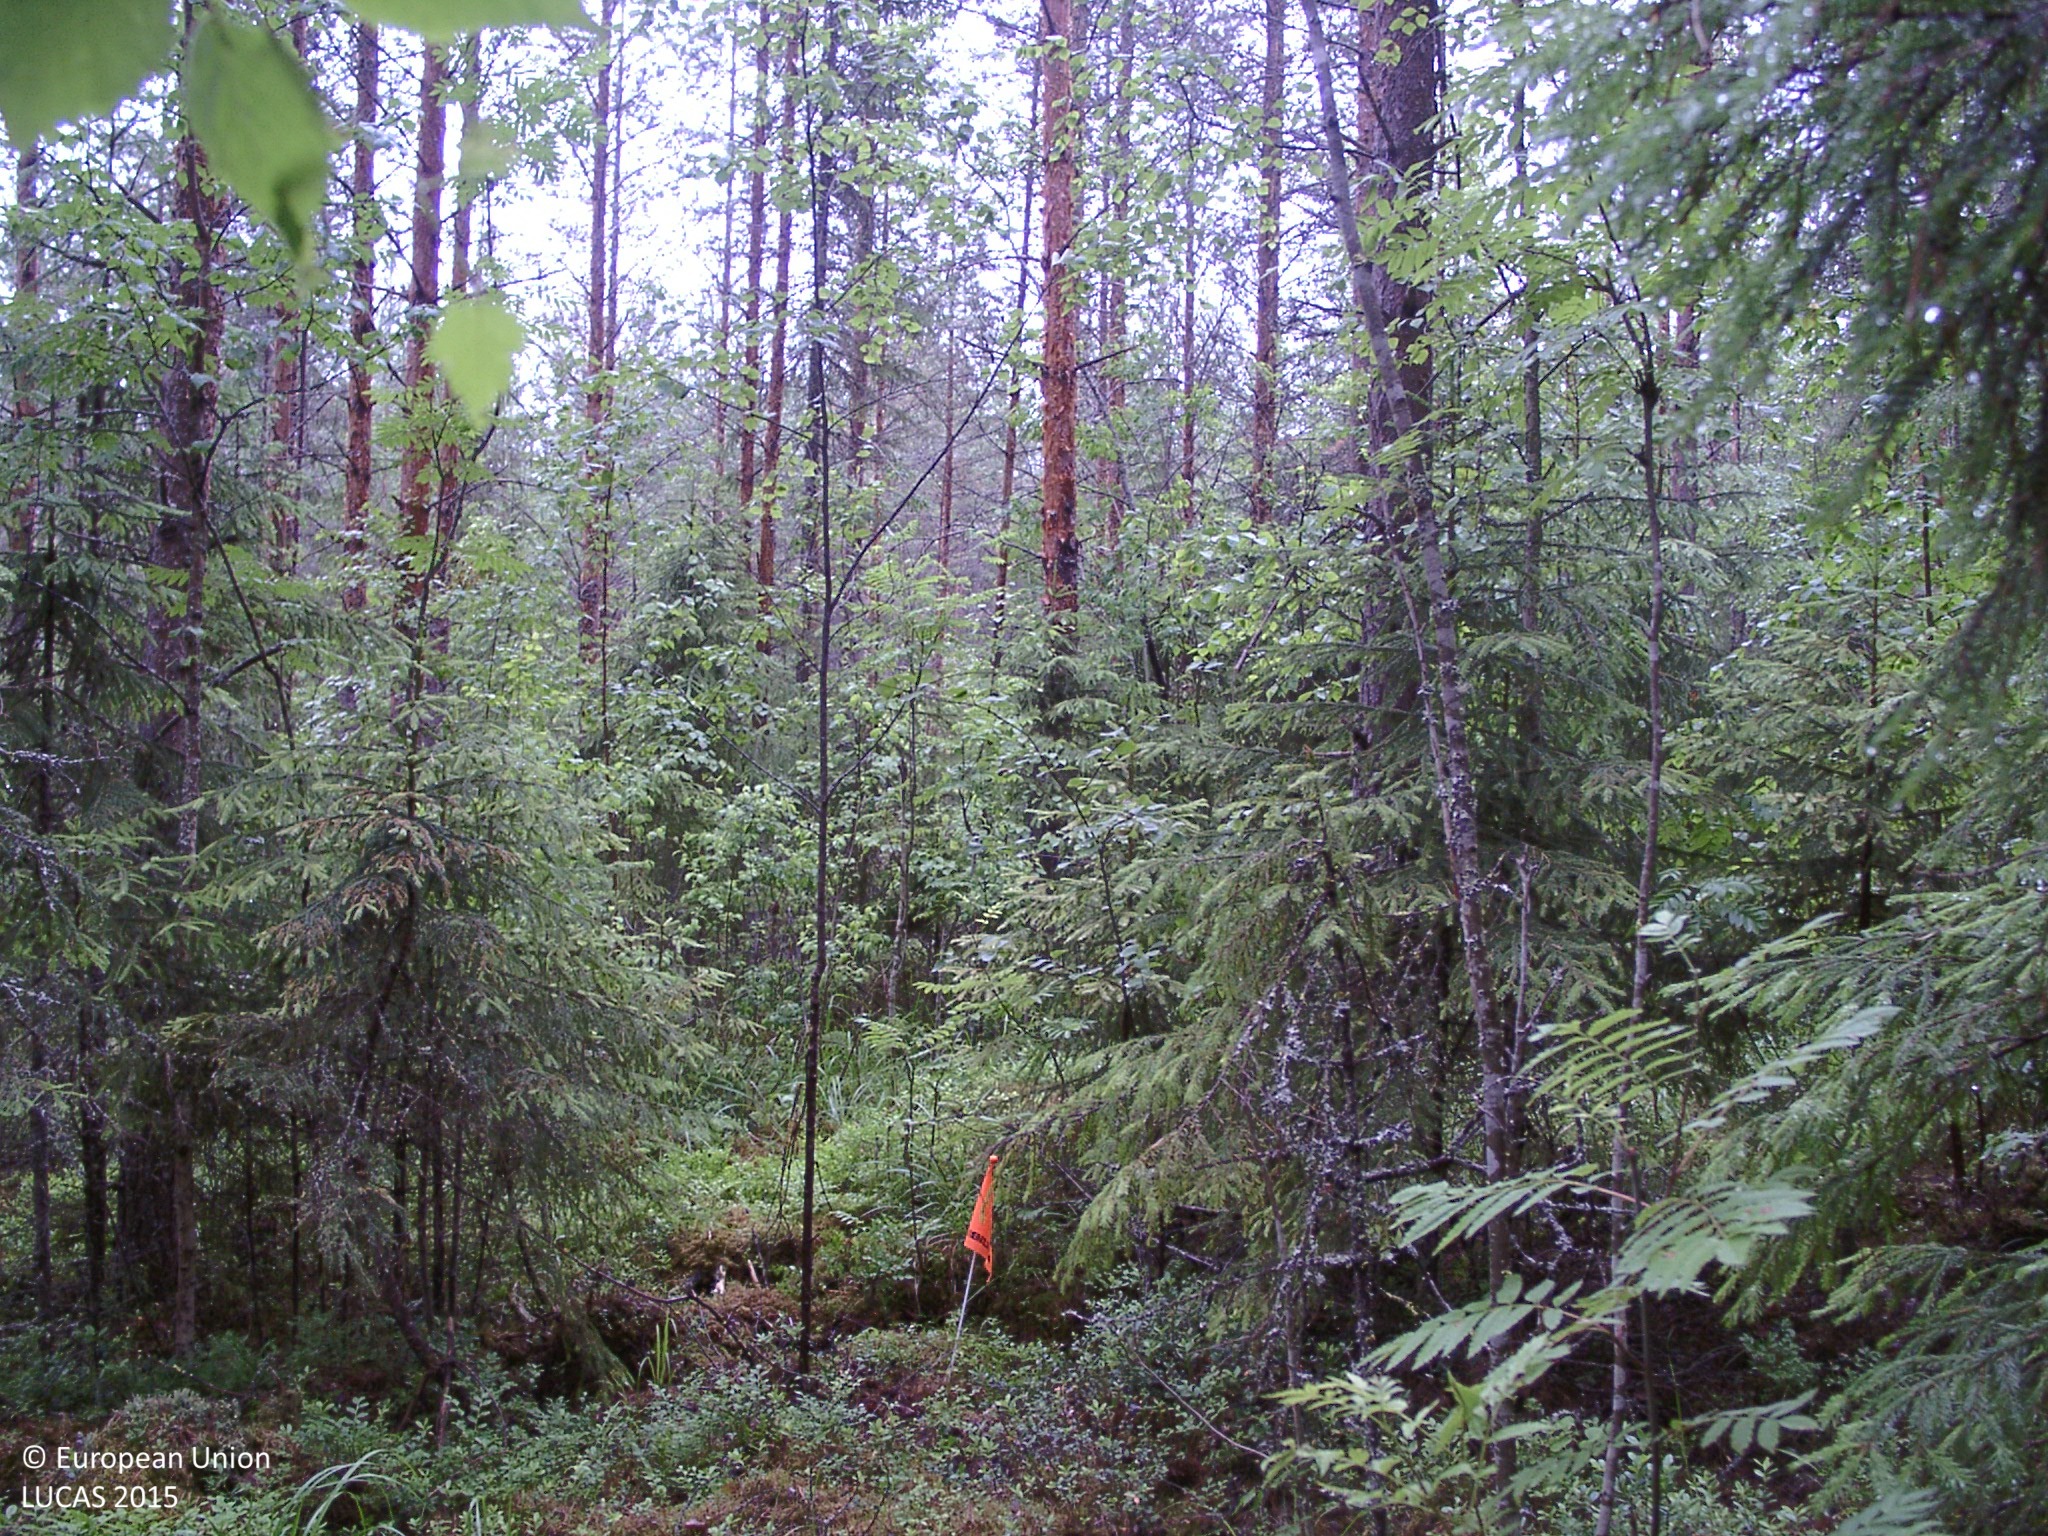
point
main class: Woodland
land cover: Other mixed woodland
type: boreal forest
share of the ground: 50 - 75 %
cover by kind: coniferous forest trees 50 %, broadleaved forest trees 35 %, shrubs 5 %, herbaceous plants 5 %, lichens and mosses 5 %
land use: Semi-natural and natural areas not in use
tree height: > 5 m
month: July
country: FI
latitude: 62.1075
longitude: 25.2274
